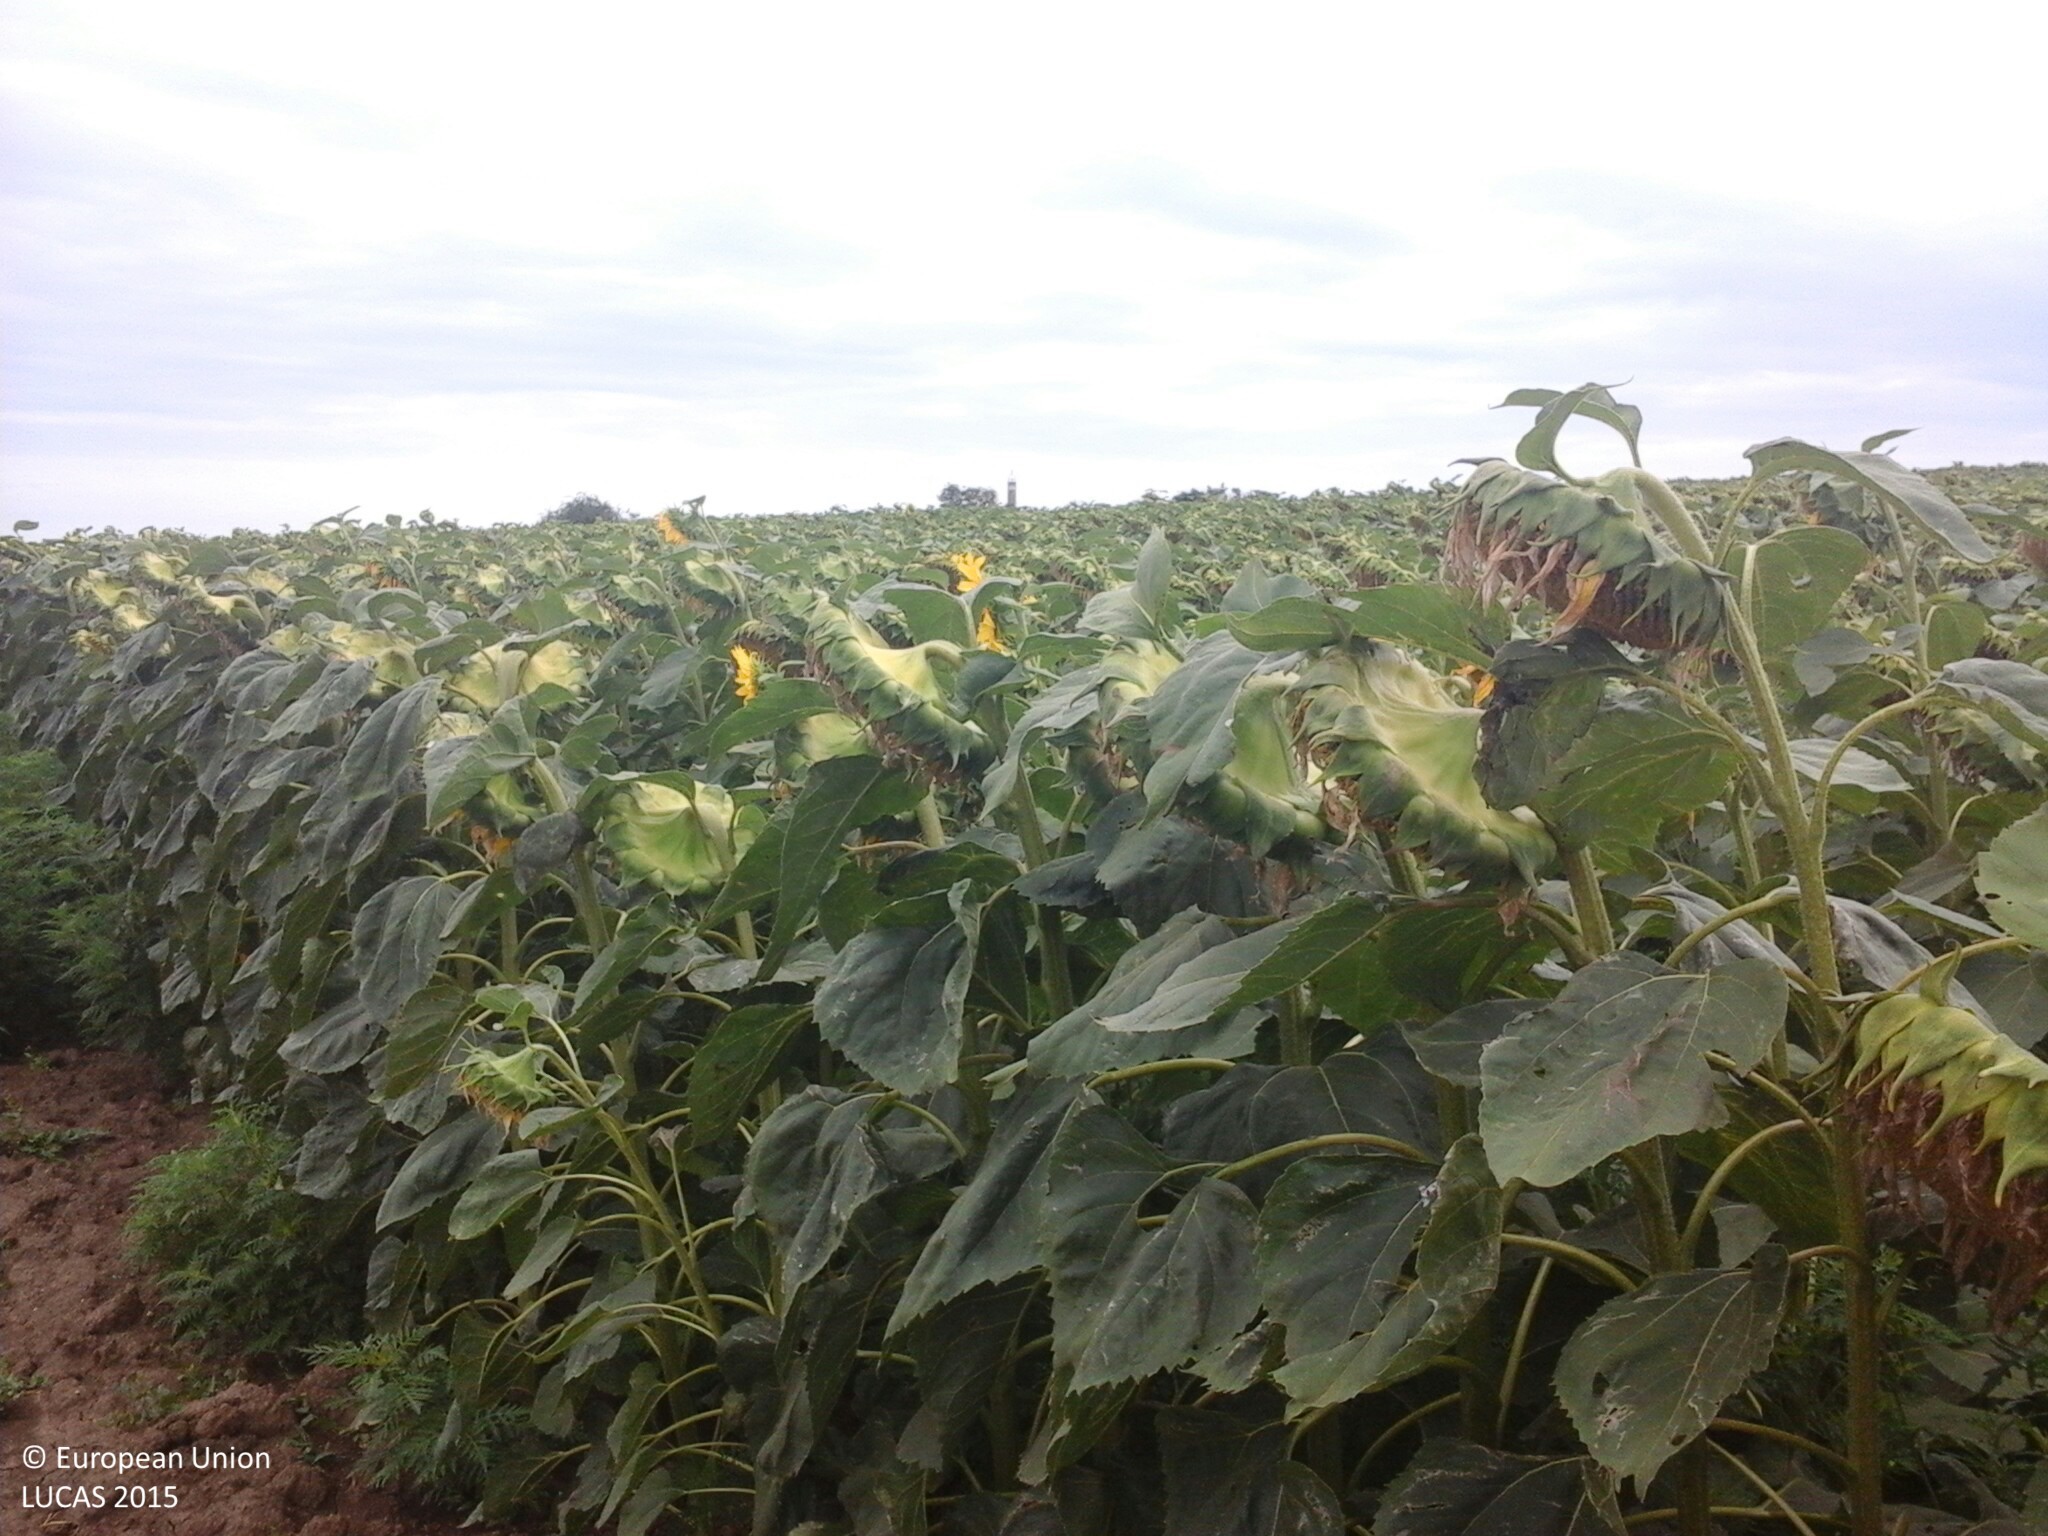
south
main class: Cropland
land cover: Sunflower
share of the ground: > 75 %
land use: Agriculture (excluding fallow land and kitchen gardens)
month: July
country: HU
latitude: 47.0585
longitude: 18.0802
